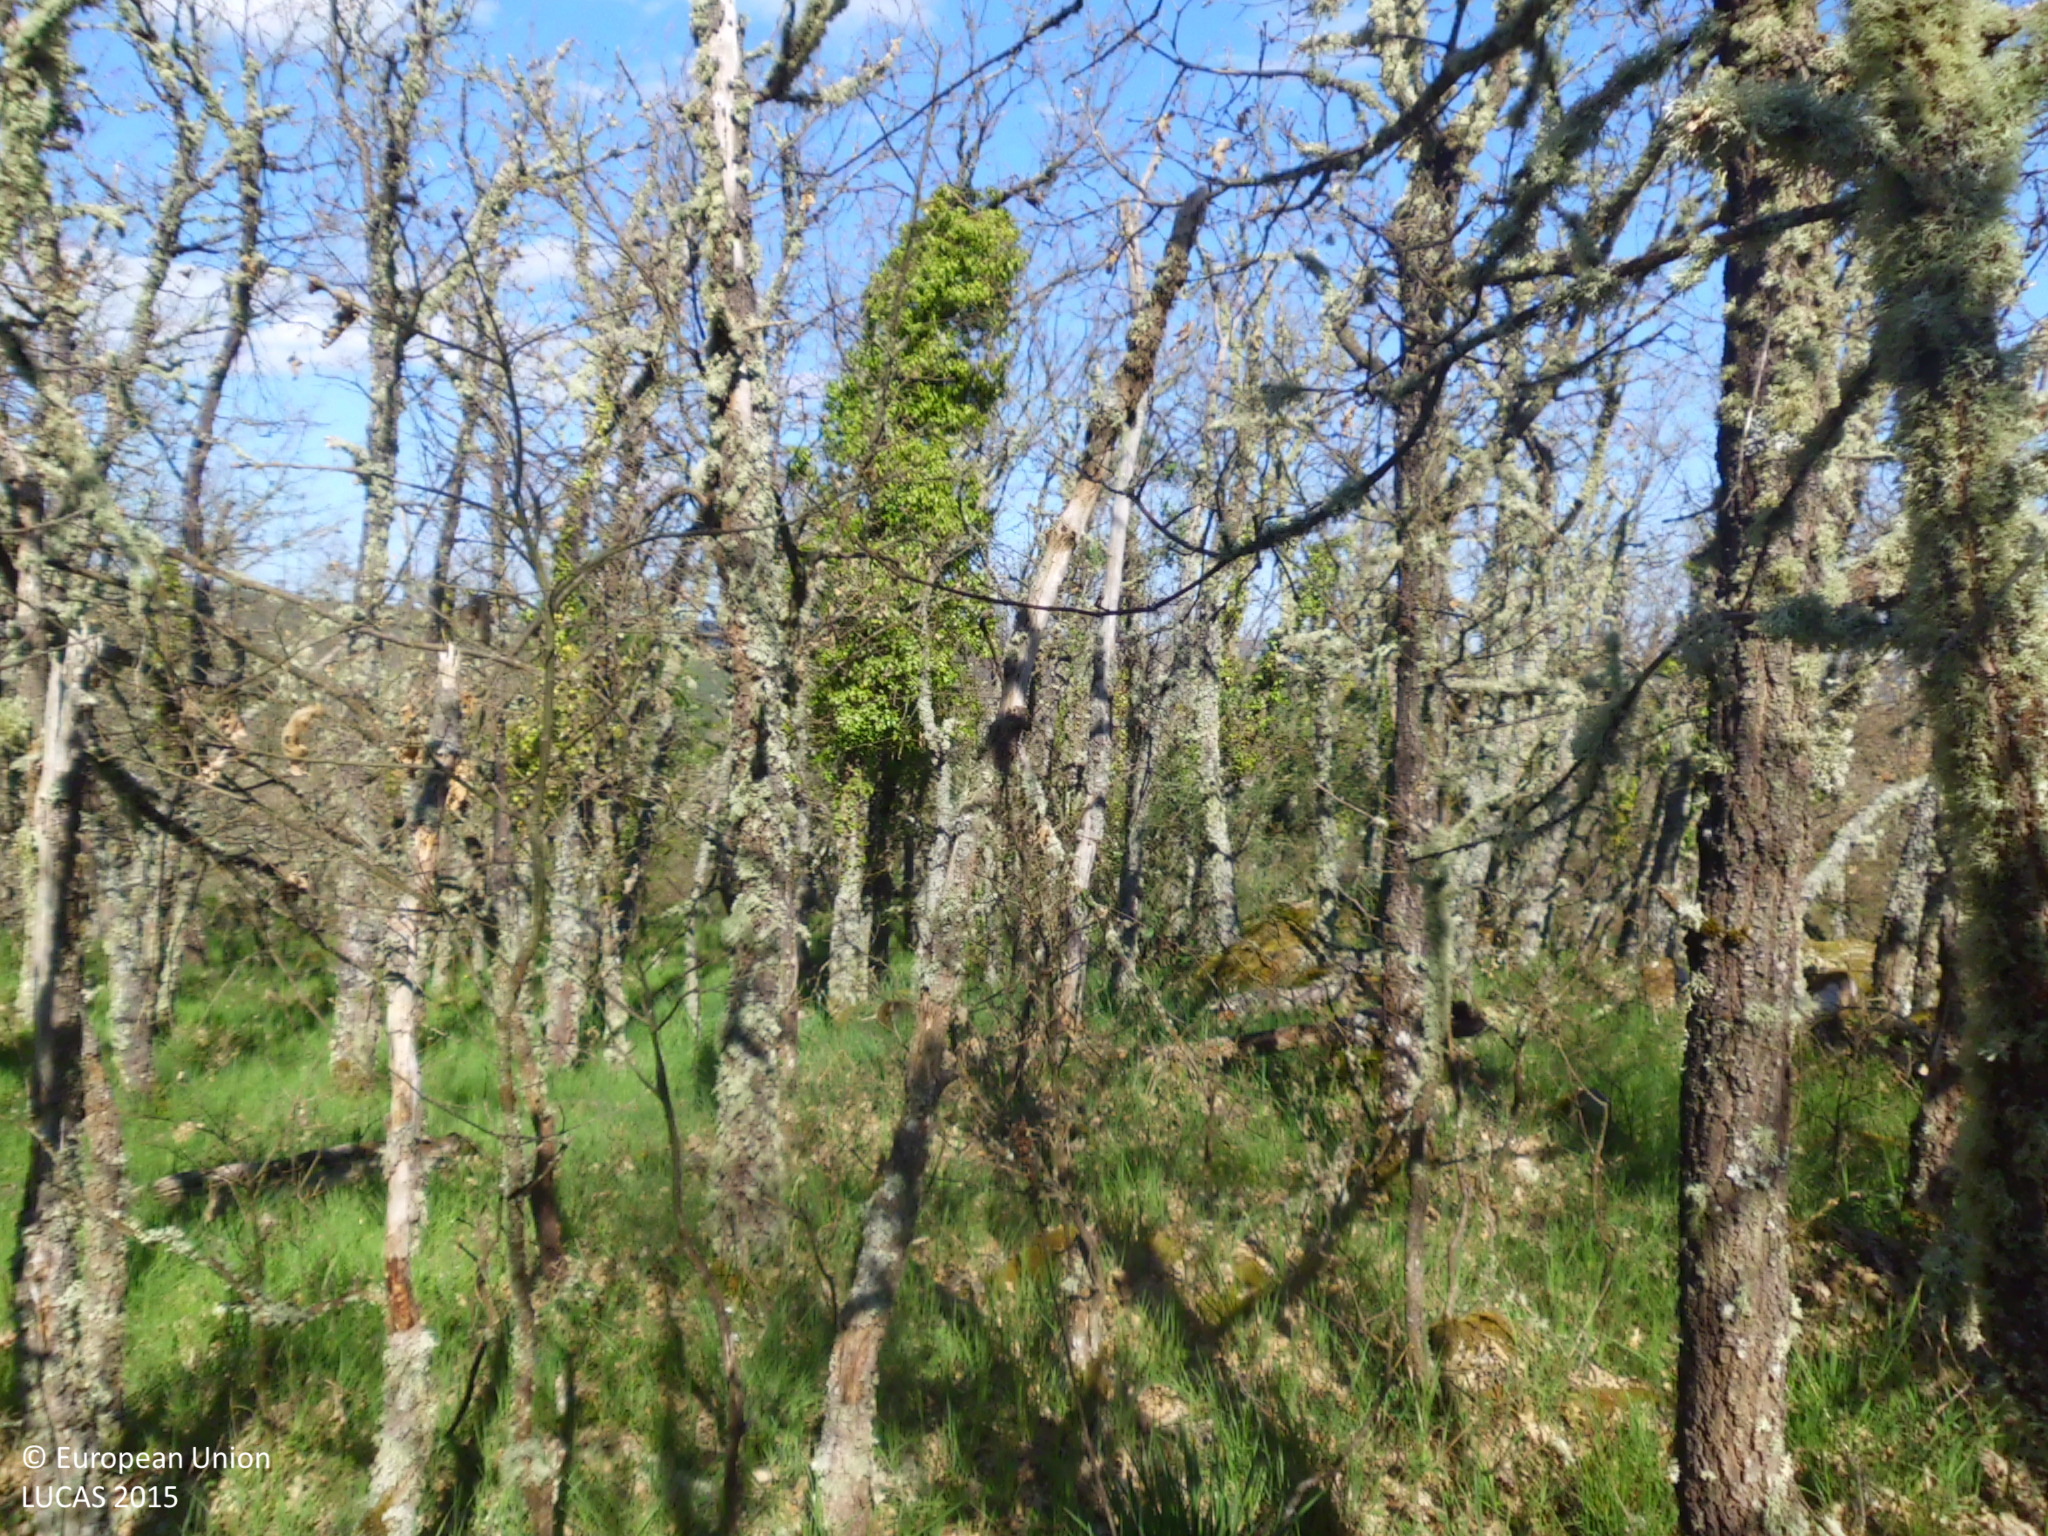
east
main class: Woodland
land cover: Broadleaved woodland
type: acidophilous oak and oak-birch forest
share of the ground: > 75 %
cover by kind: broadleaved forest trees 85 %, shrubs 10 %, herbaceous plants 5 %
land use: Semi-natural and natural areas not in use
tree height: < 5 m
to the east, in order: Broadleaved woodland
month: May
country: ES
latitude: 42.8185
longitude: -4.0759
